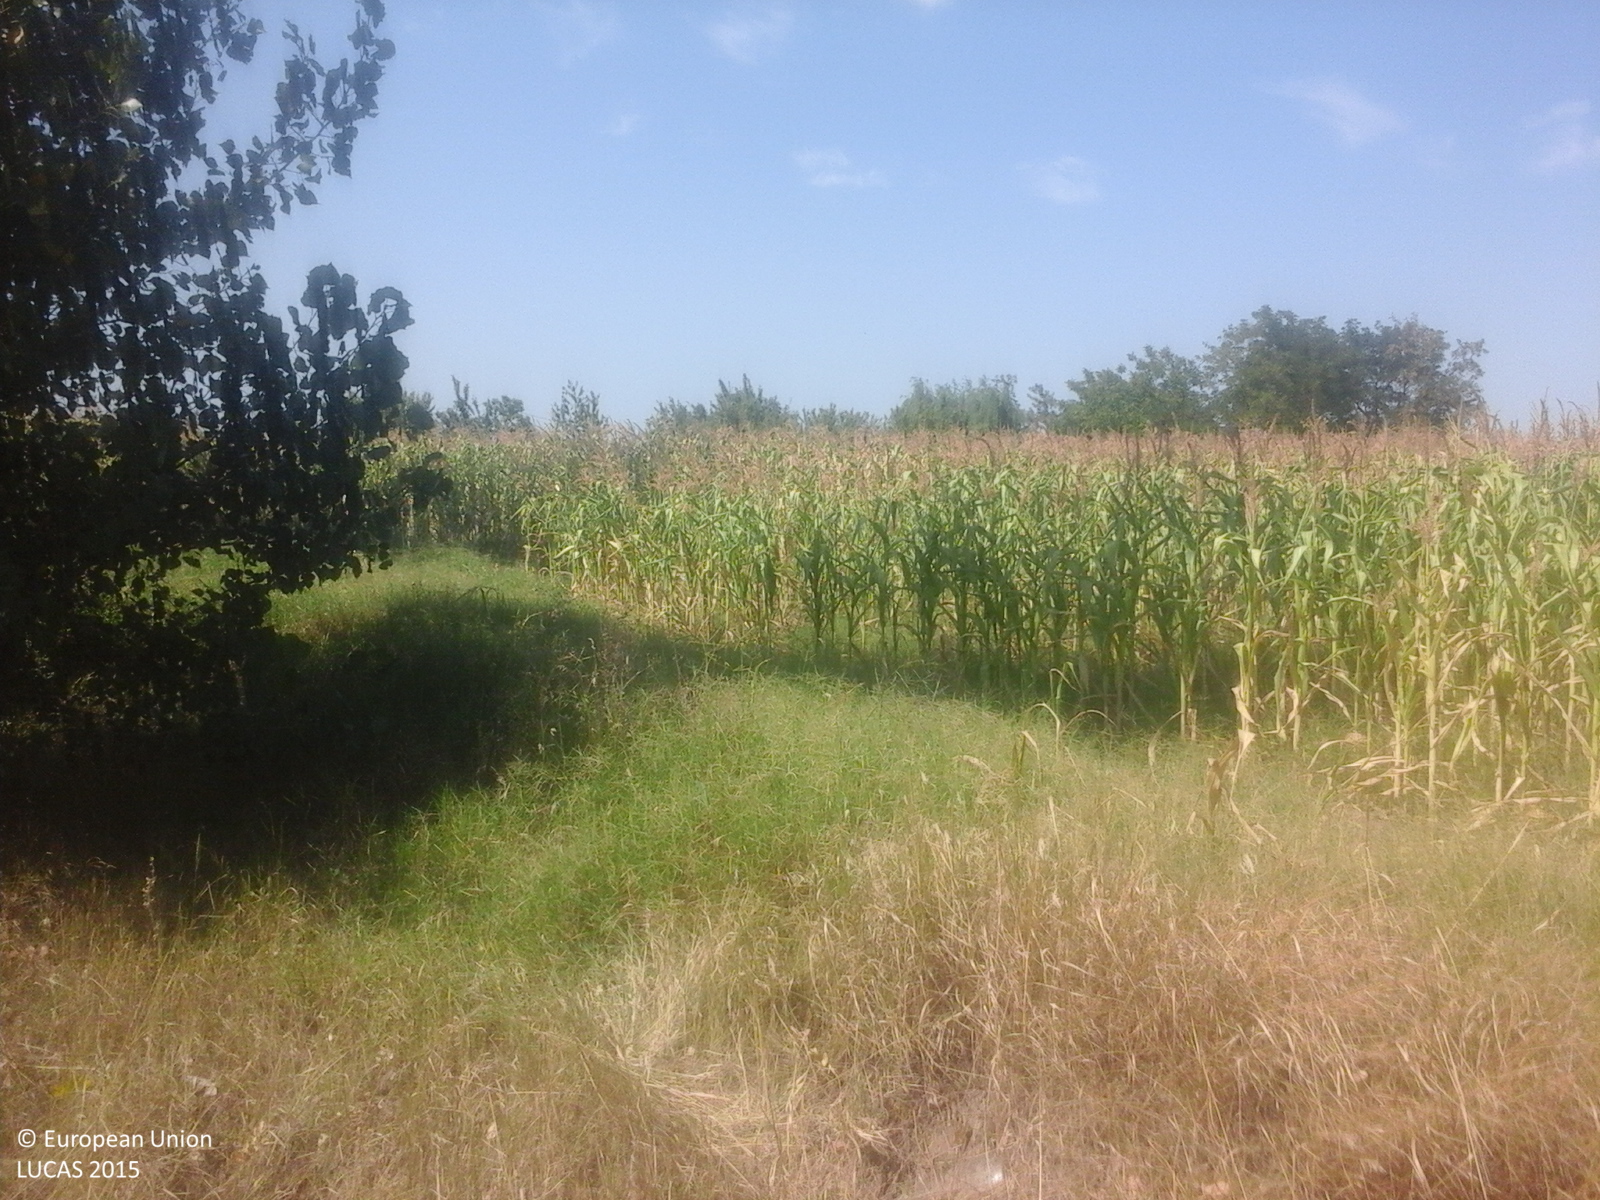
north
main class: Cropland
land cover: Maize
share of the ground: > 75 %
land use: Agriculture (excluding fallow land and kitchen gardens)
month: August
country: RO
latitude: 45.0699
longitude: 26.8847
